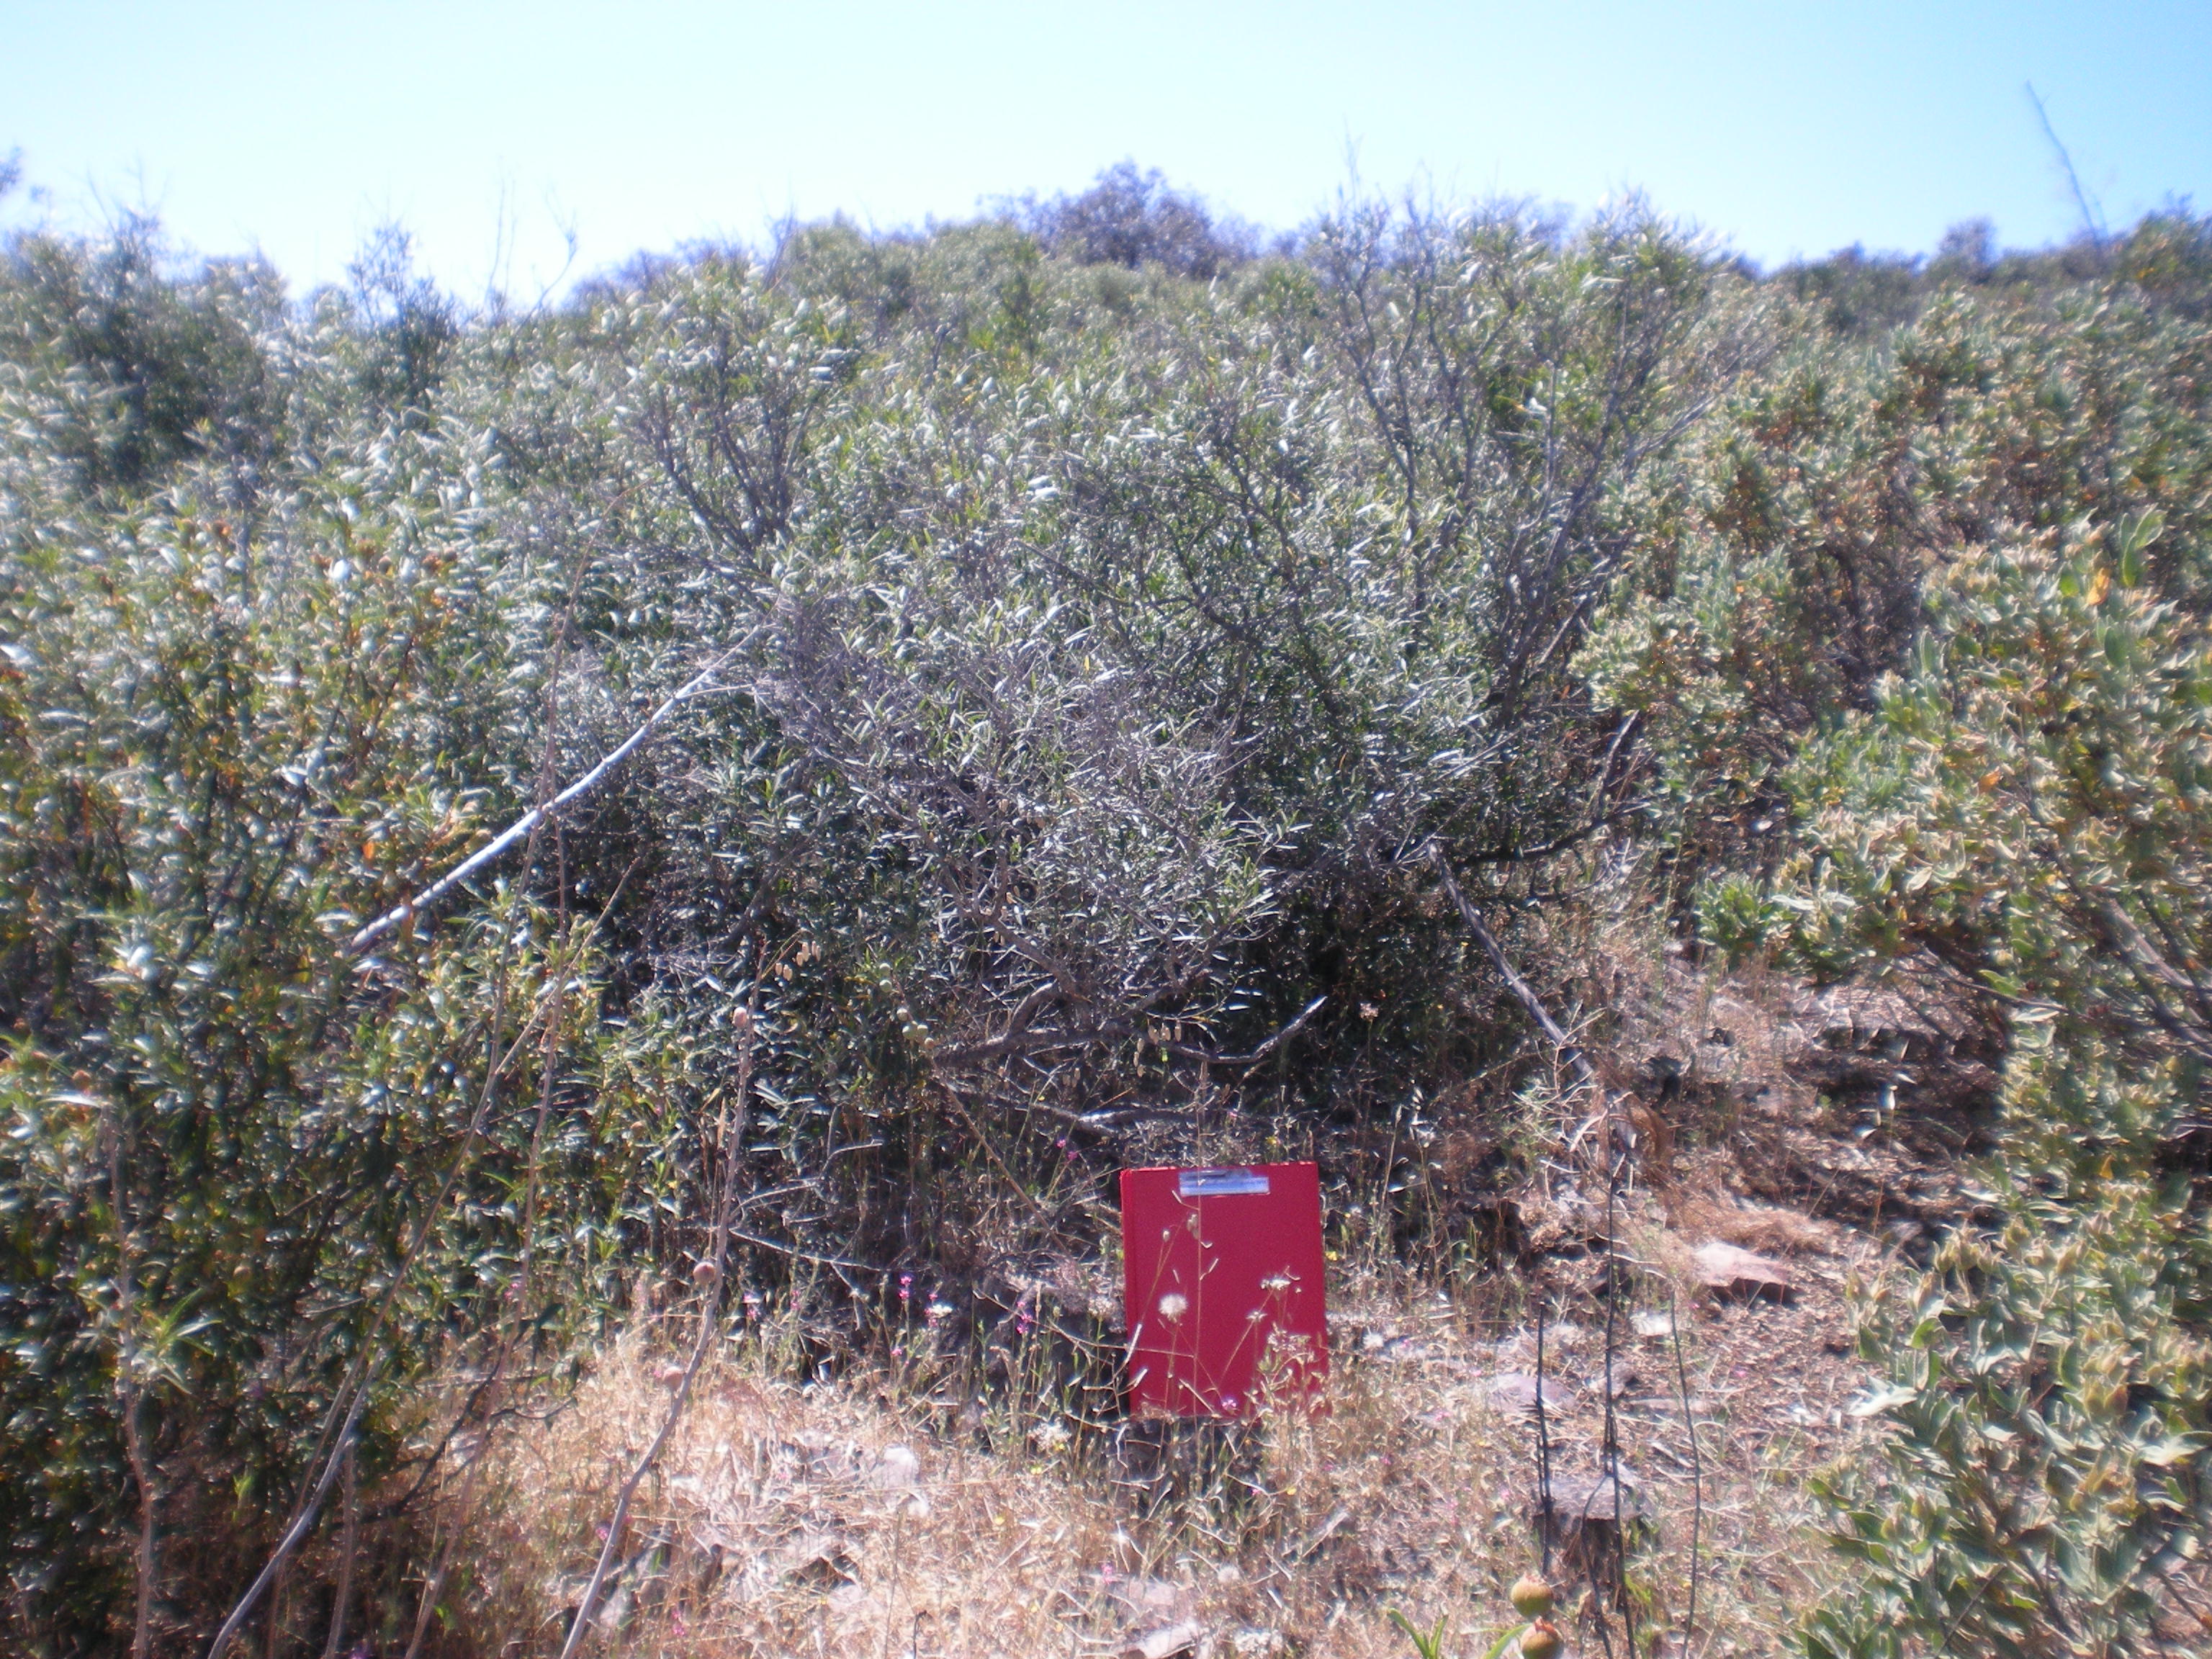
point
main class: Shrubland
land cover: Shrubland with sparse tree cover
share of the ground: > 75 %
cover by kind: shrubs 75 %, herbaceous plants 10 %, unconsolidated bare surface 10 %, broadleaved forest trees 5 %
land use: Forestry
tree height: < 5 m
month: May
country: ES
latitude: 38.4926
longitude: -3.4566
